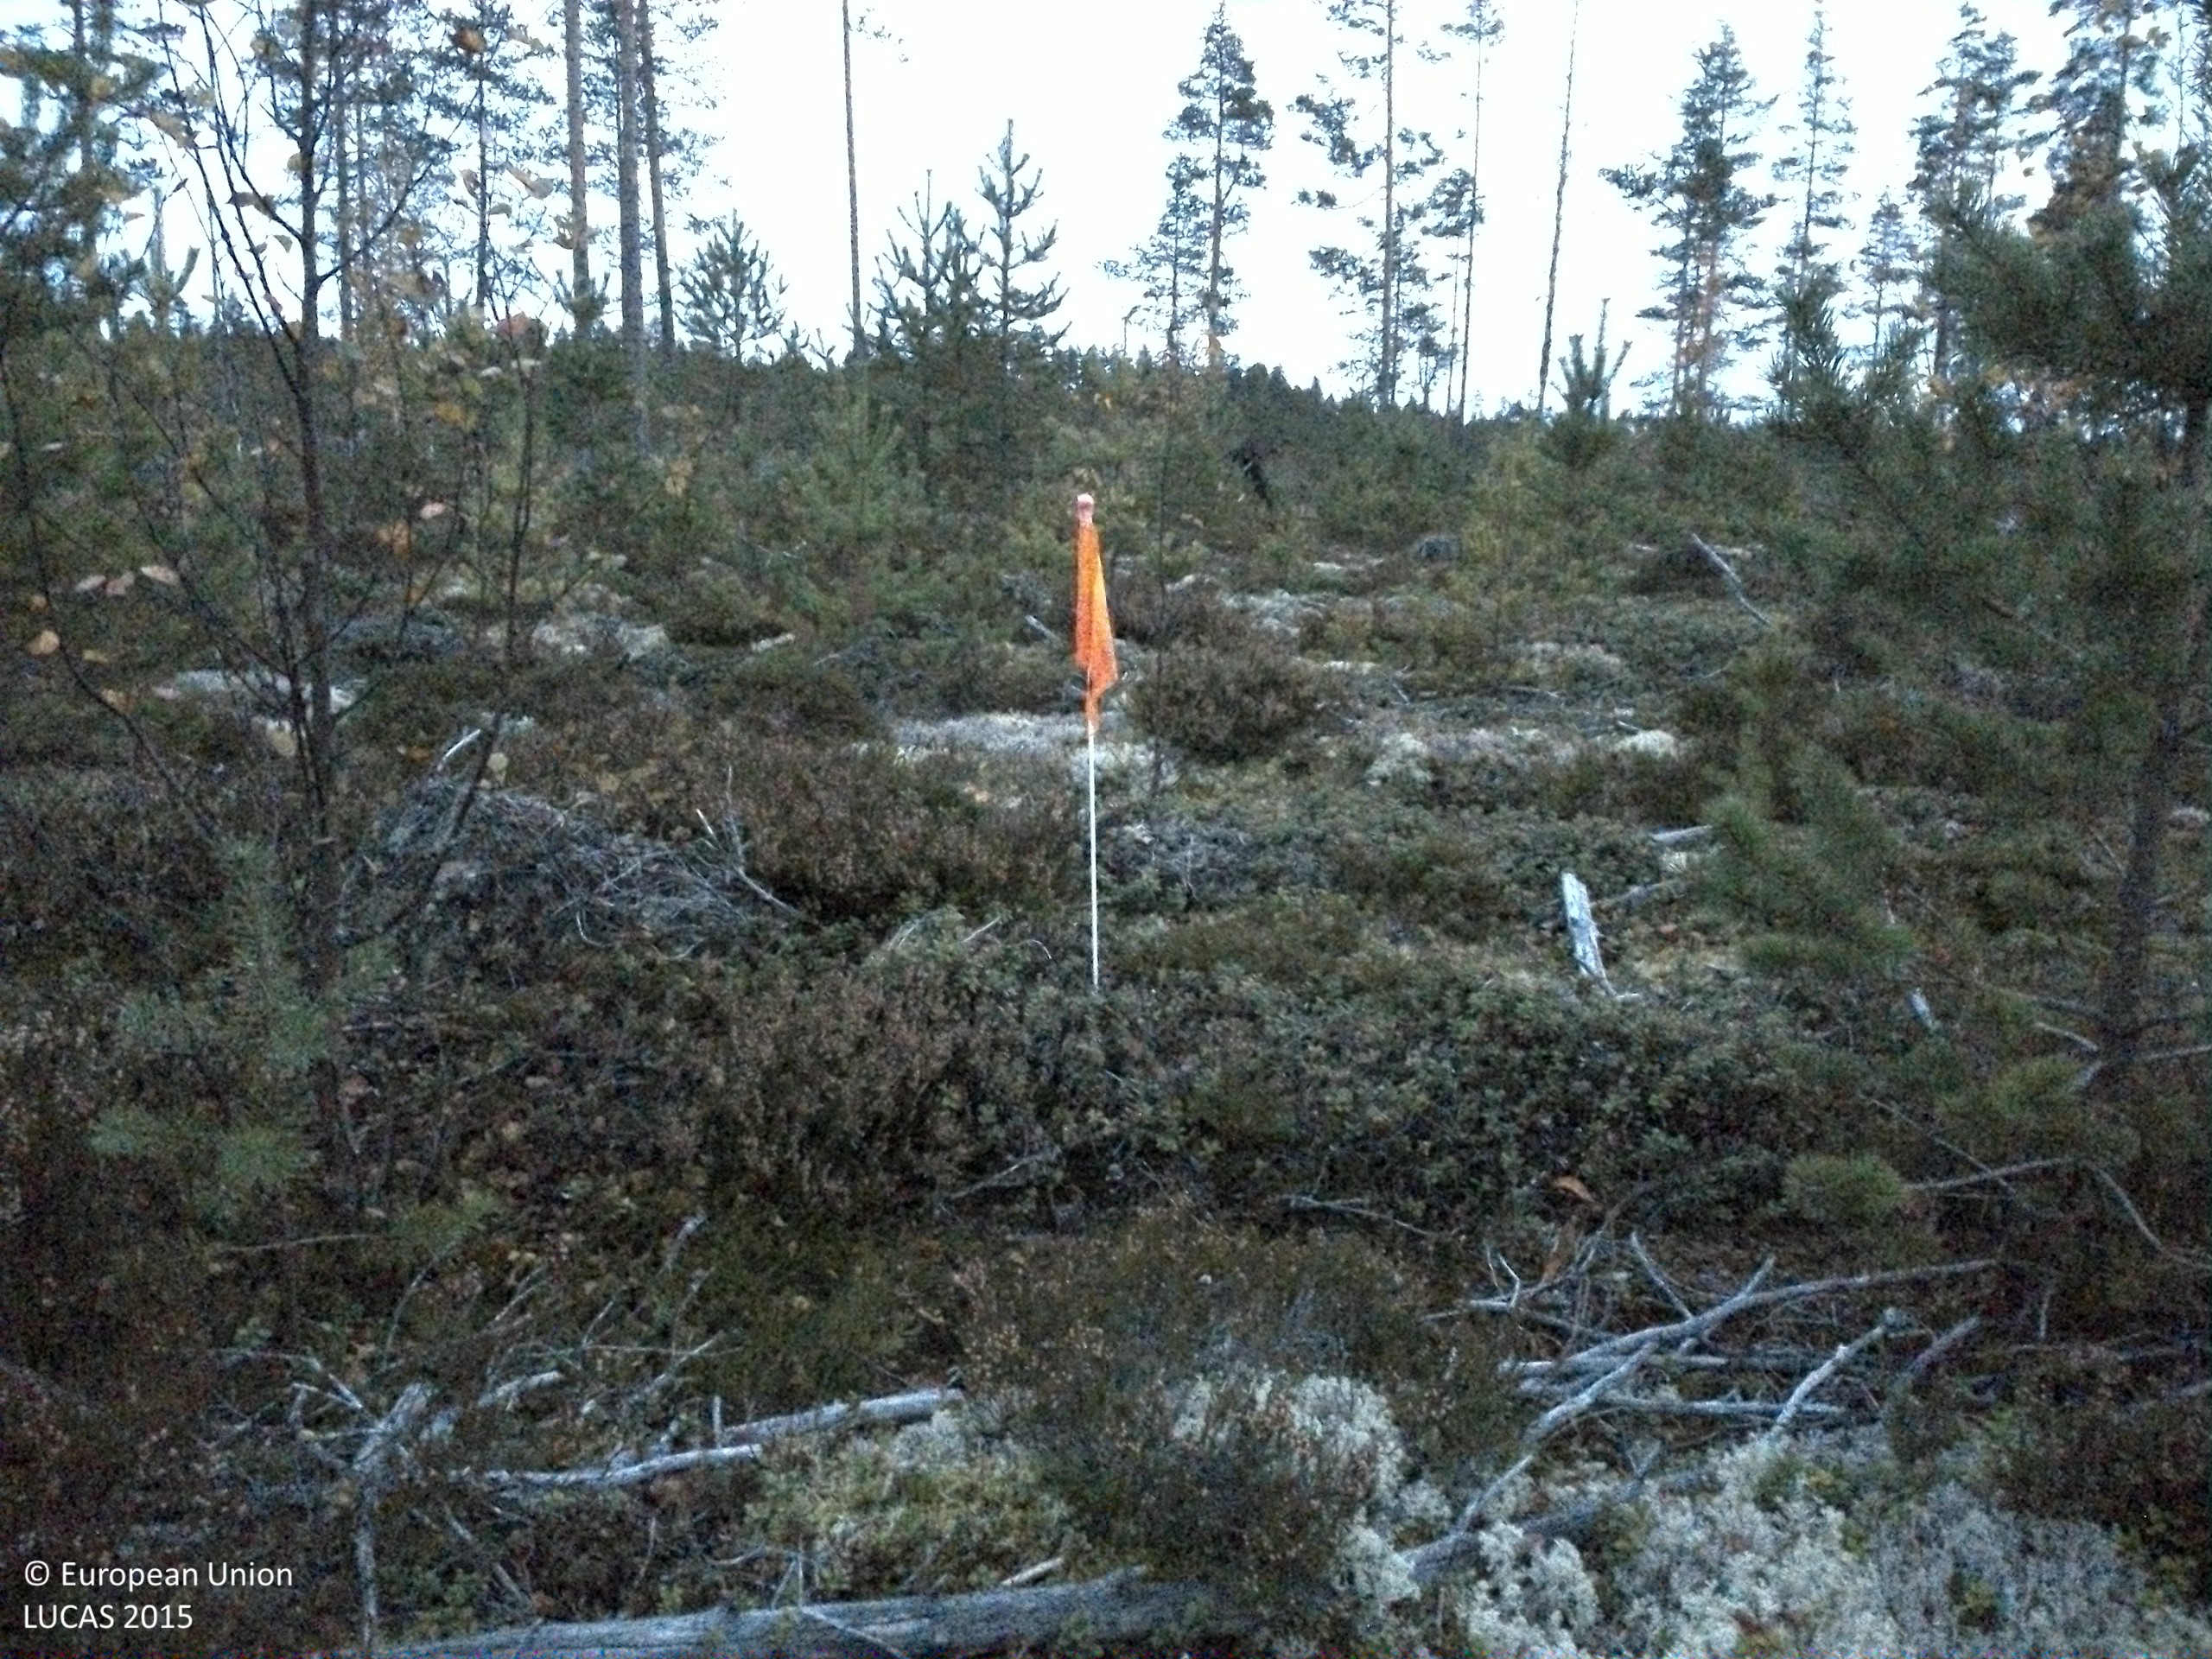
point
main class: Woodland
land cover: Pine dominated coniferous woodland
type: boreal forest
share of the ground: 25 - 50 %
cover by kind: shrubs 40 %, coniferous forest trees 35 %, lichens and mosses 10 %, consolidated bare surface 10 %, broadleaved forest trees 5 %
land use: Forestry
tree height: < 5 m
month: October
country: SE
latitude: 61.3343
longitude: 15.0866
